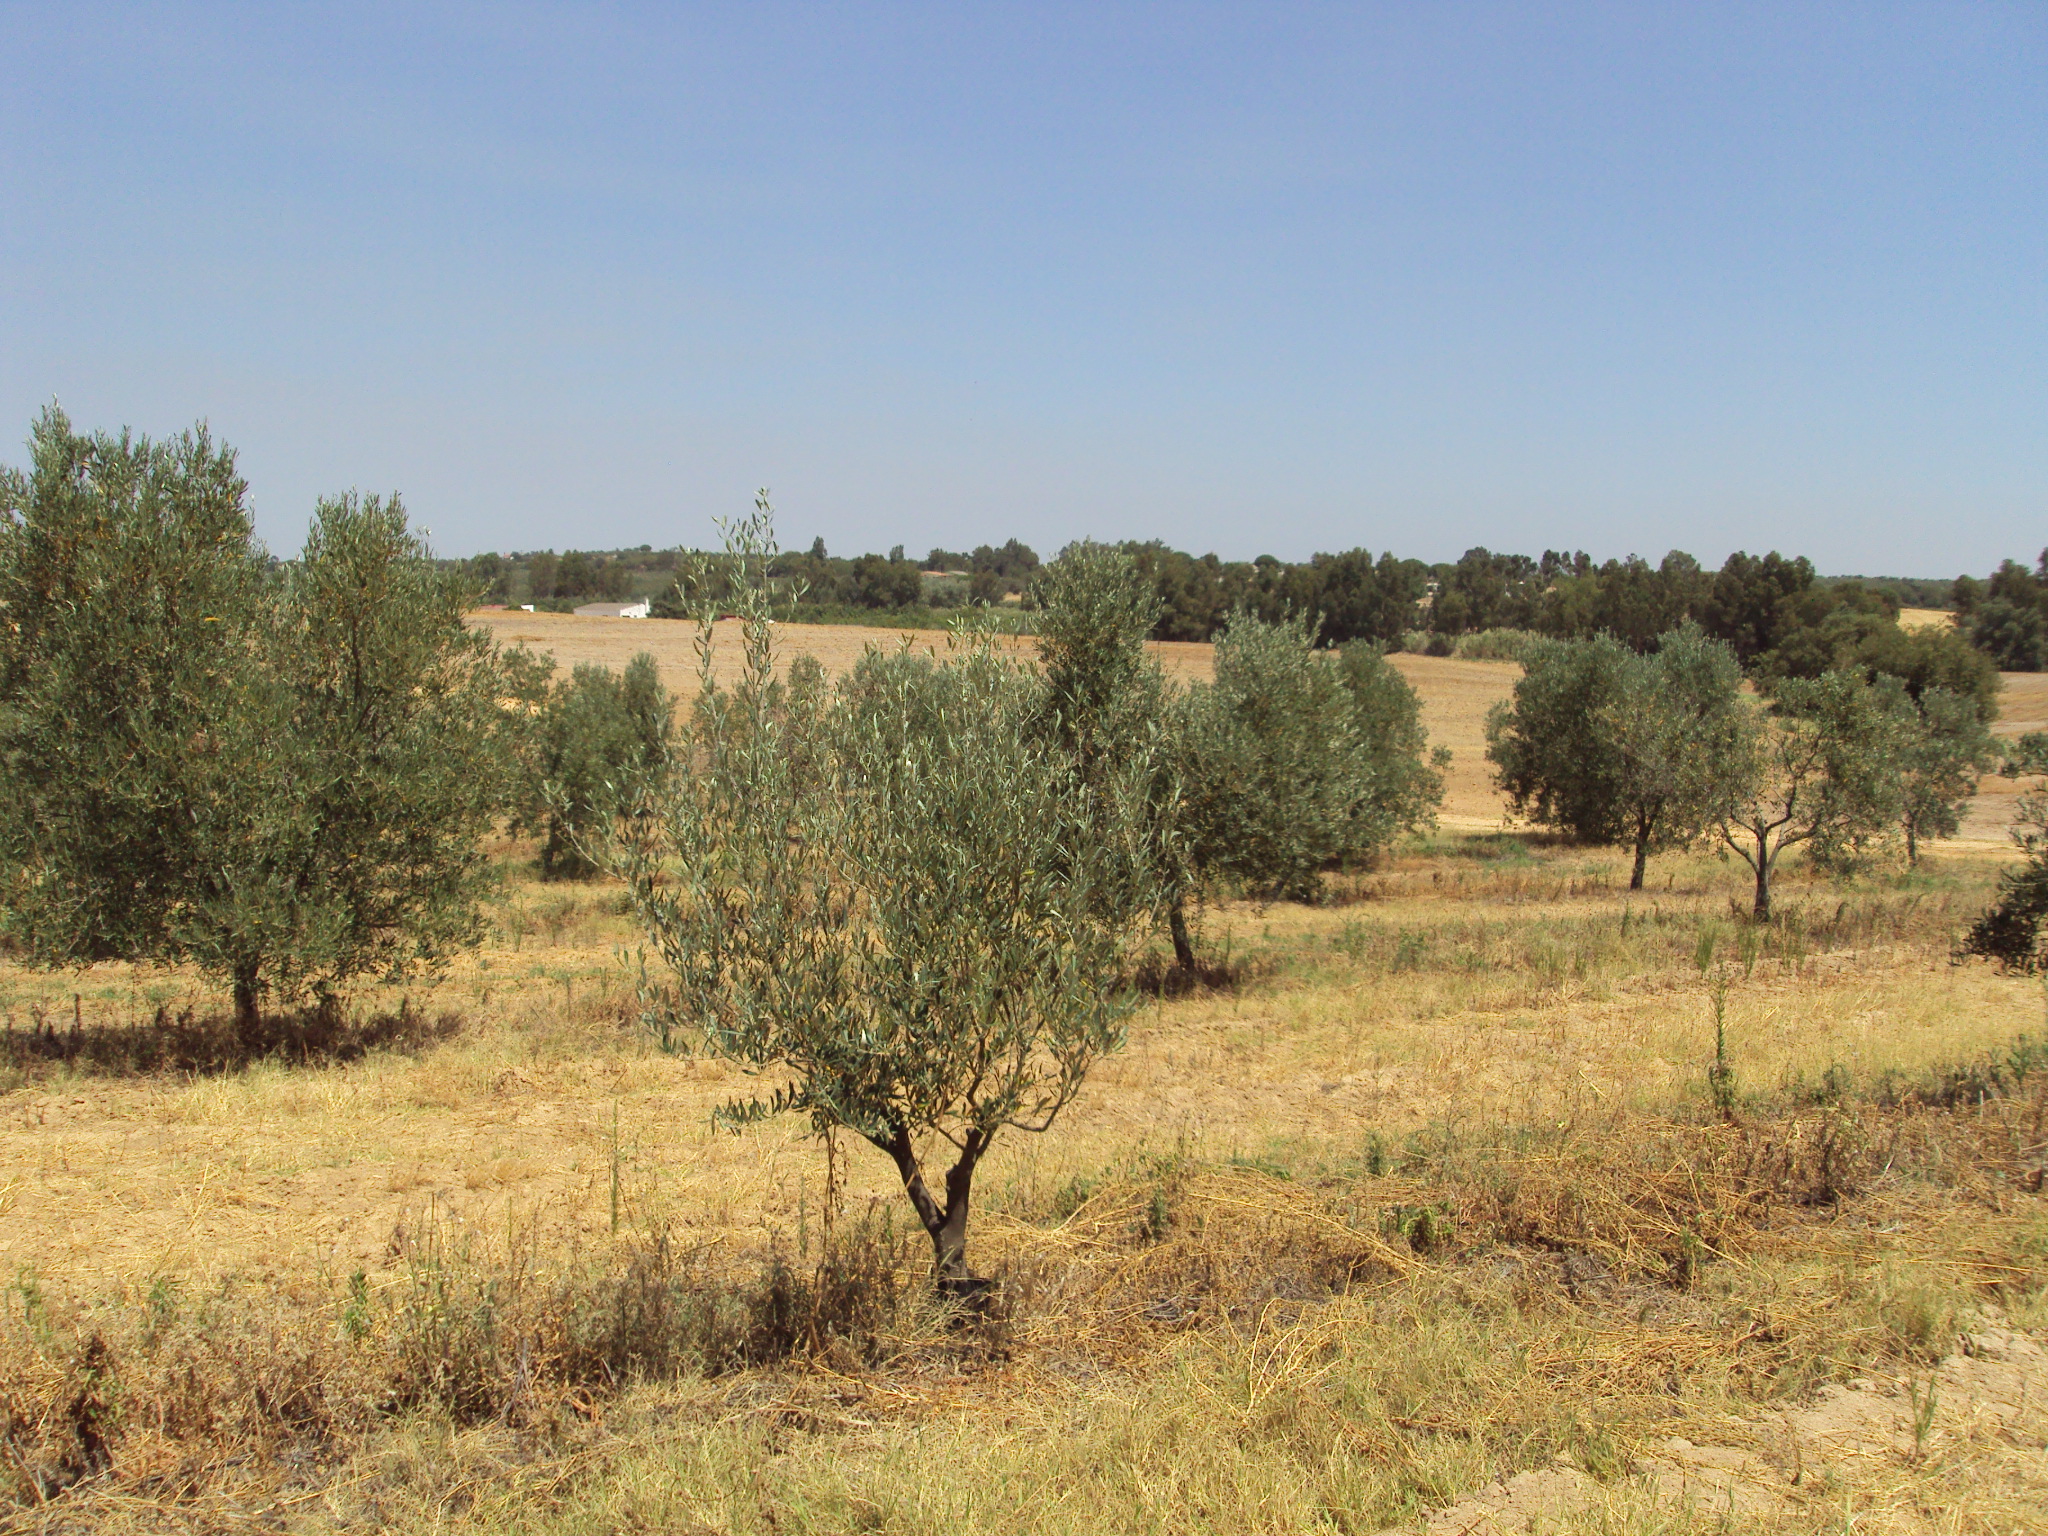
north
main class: Cropland
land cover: Olive groves
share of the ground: 50 - 75 %
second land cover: Spontaneously vegetated surfaces
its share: > 75 %
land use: Agriculture (excluding fallow land and kitchen gardens)
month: July
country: ES
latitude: 37.3447
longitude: -7.0303
